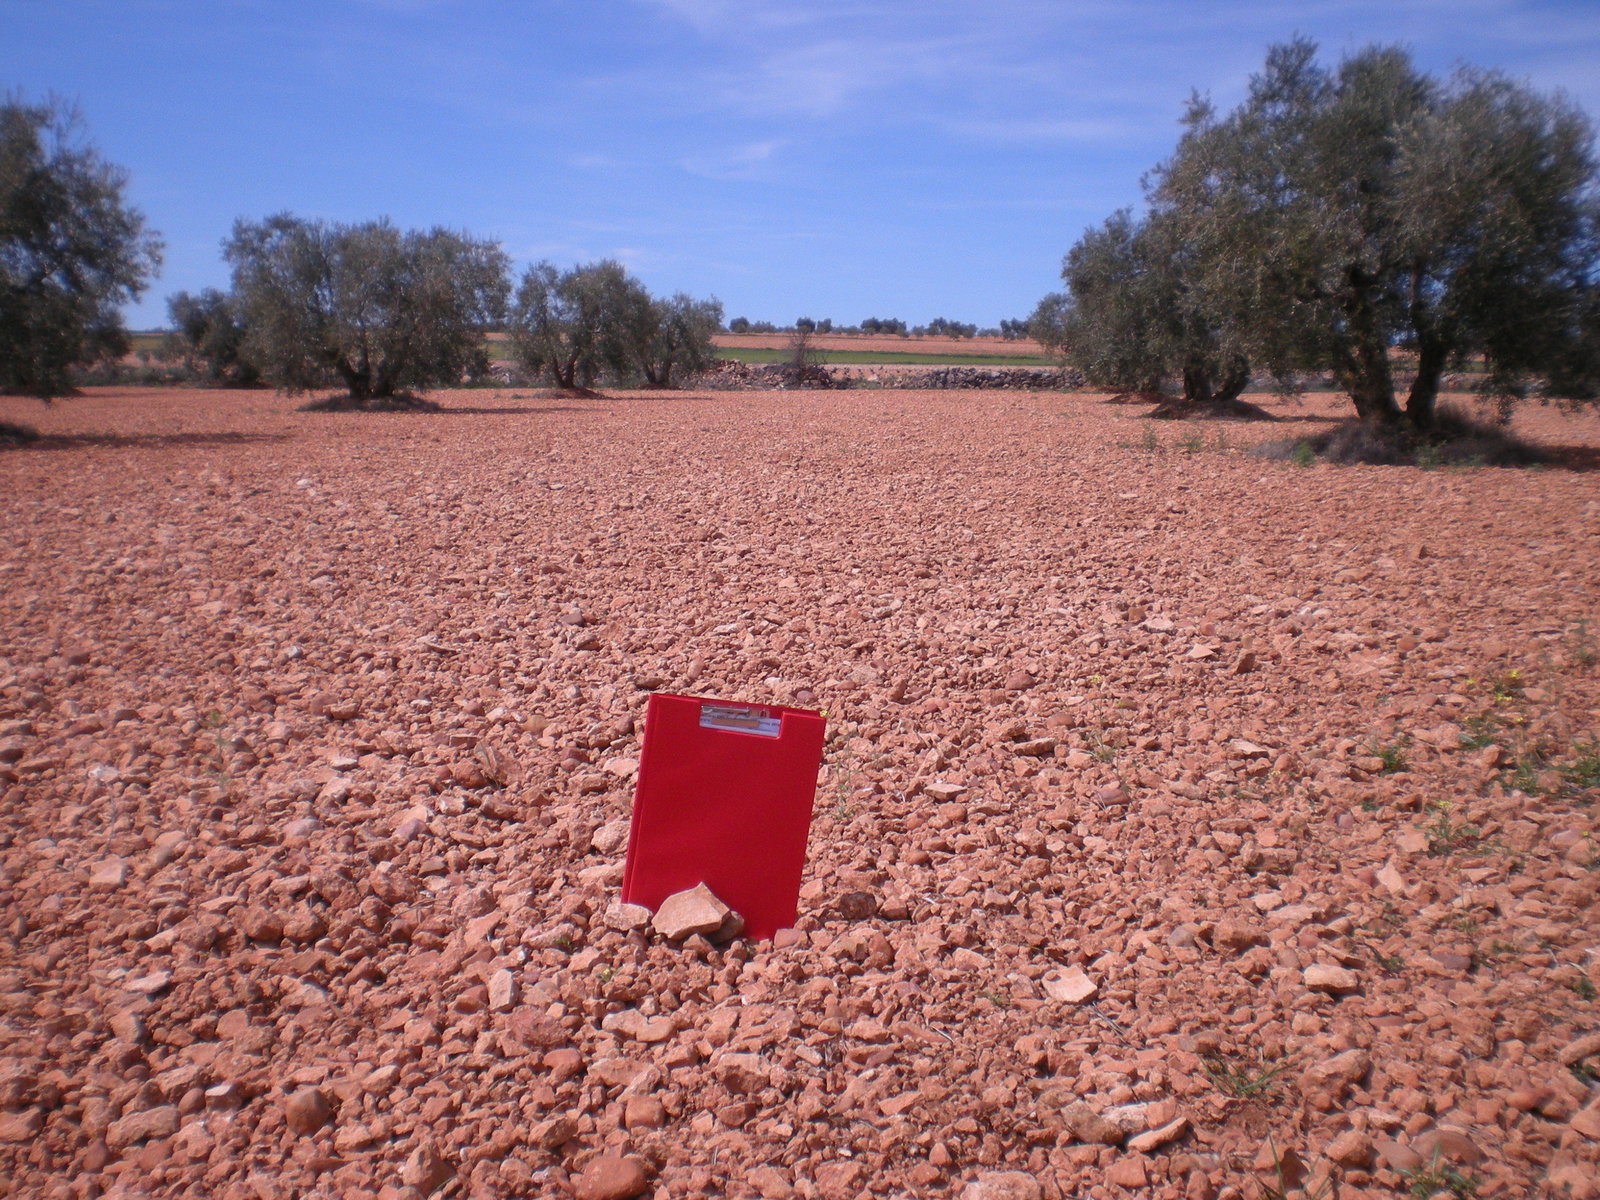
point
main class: Cropland
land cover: Olive groves
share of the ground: 10 - 25 %
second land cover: Other bare soil
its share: > 75 %
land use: Agriculture (excluding fallow land and kitchen gardens)
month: March
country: ES
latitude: 39.0181
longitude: -3.2374
